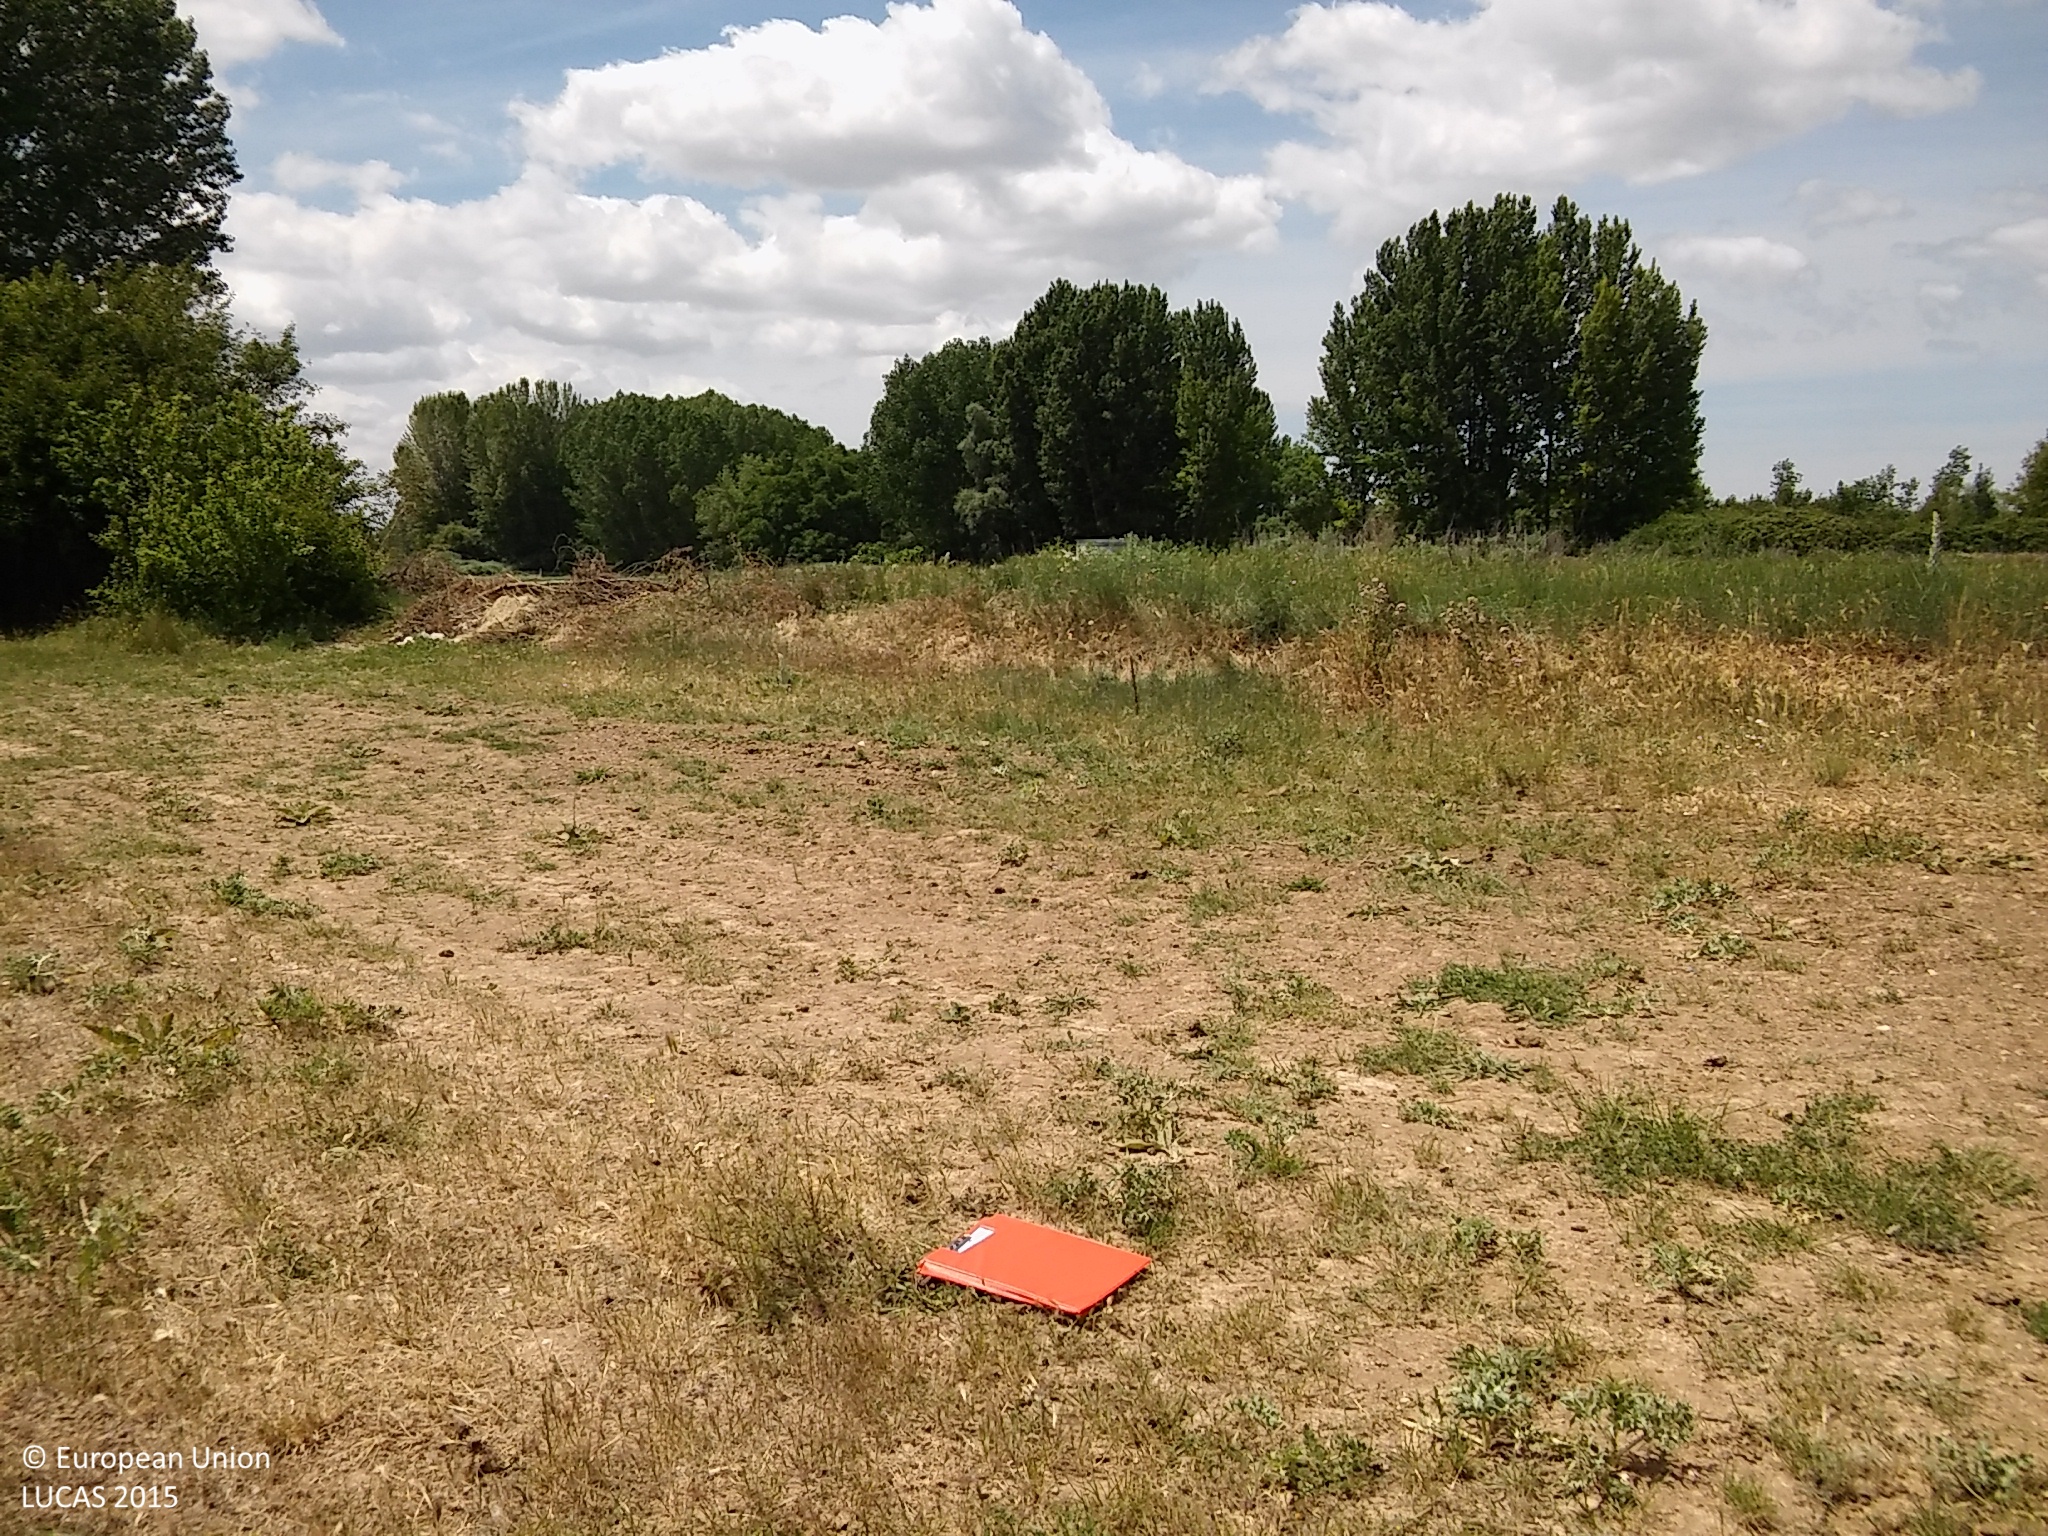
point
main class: Grassland
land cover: Grassland without tree/shrub cover
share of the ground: 50 - 75 %
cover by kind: herbaceous plants 60 %, unconsolidated bare surface 40 %
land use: Agriculture (excluding fallow land and kitchen gardens)
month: May
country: ES
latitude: 41.6430
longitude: -3.5816
